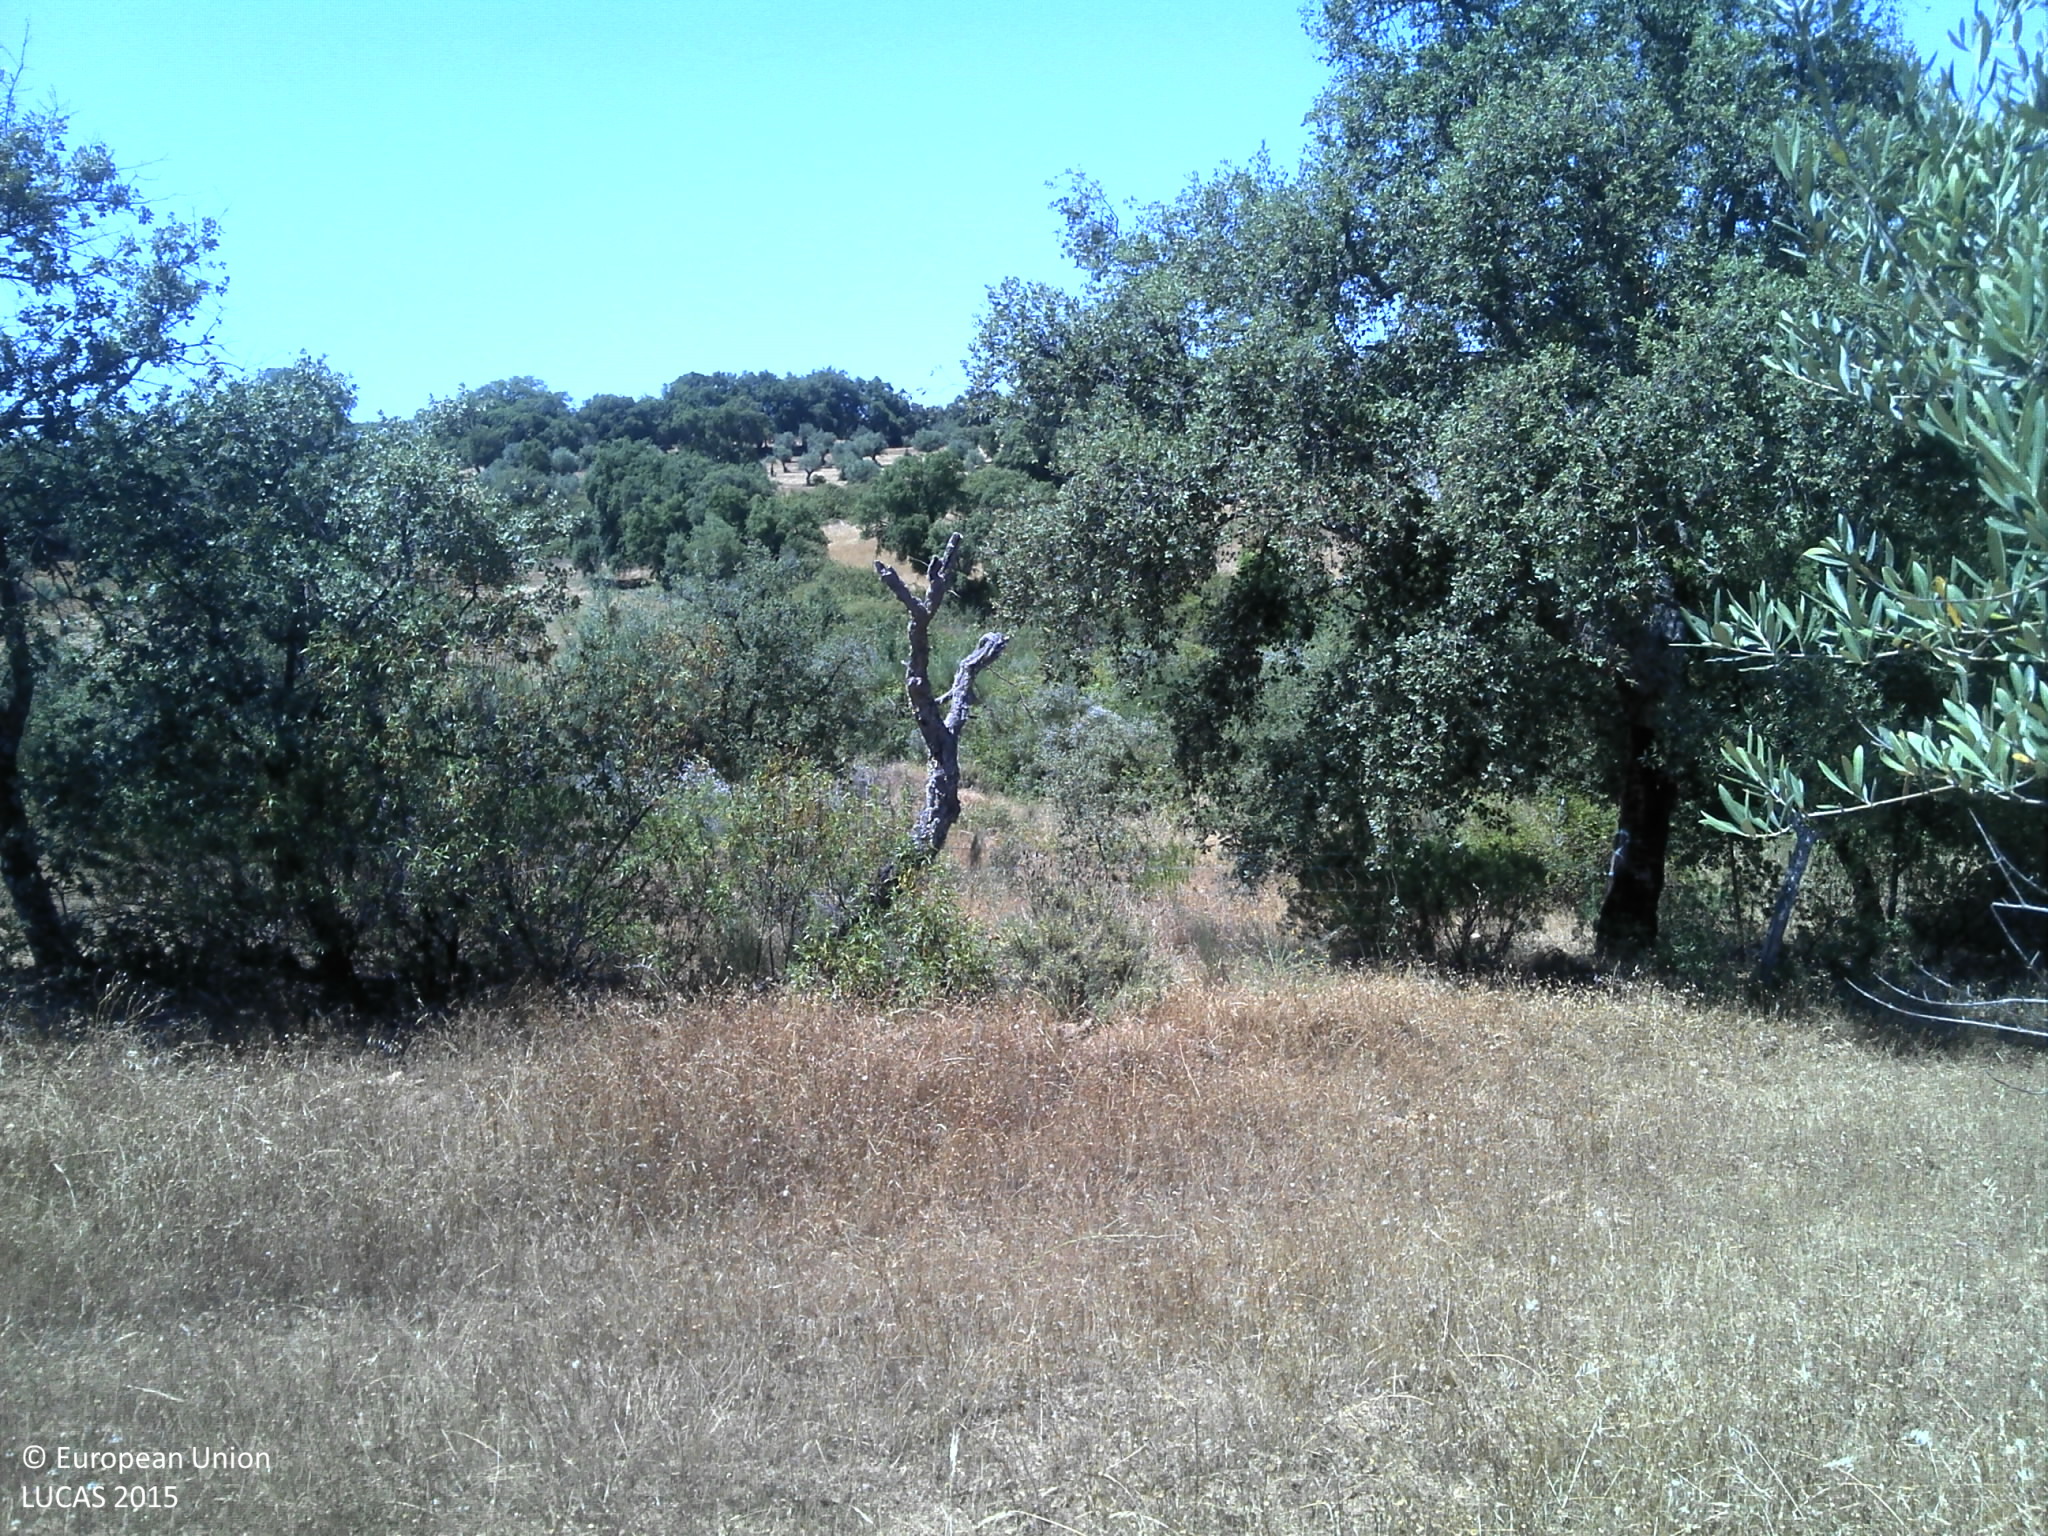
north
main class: Cropland
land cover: Olive groves
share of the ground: 25 - 50 %
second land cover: Grassland without tree/shrub cover
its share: 50 - 75 %
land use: Agriculture (excluding fallow land and kitchen gardens)
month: June
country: PT
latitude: 40.0322
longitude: -7.1692
